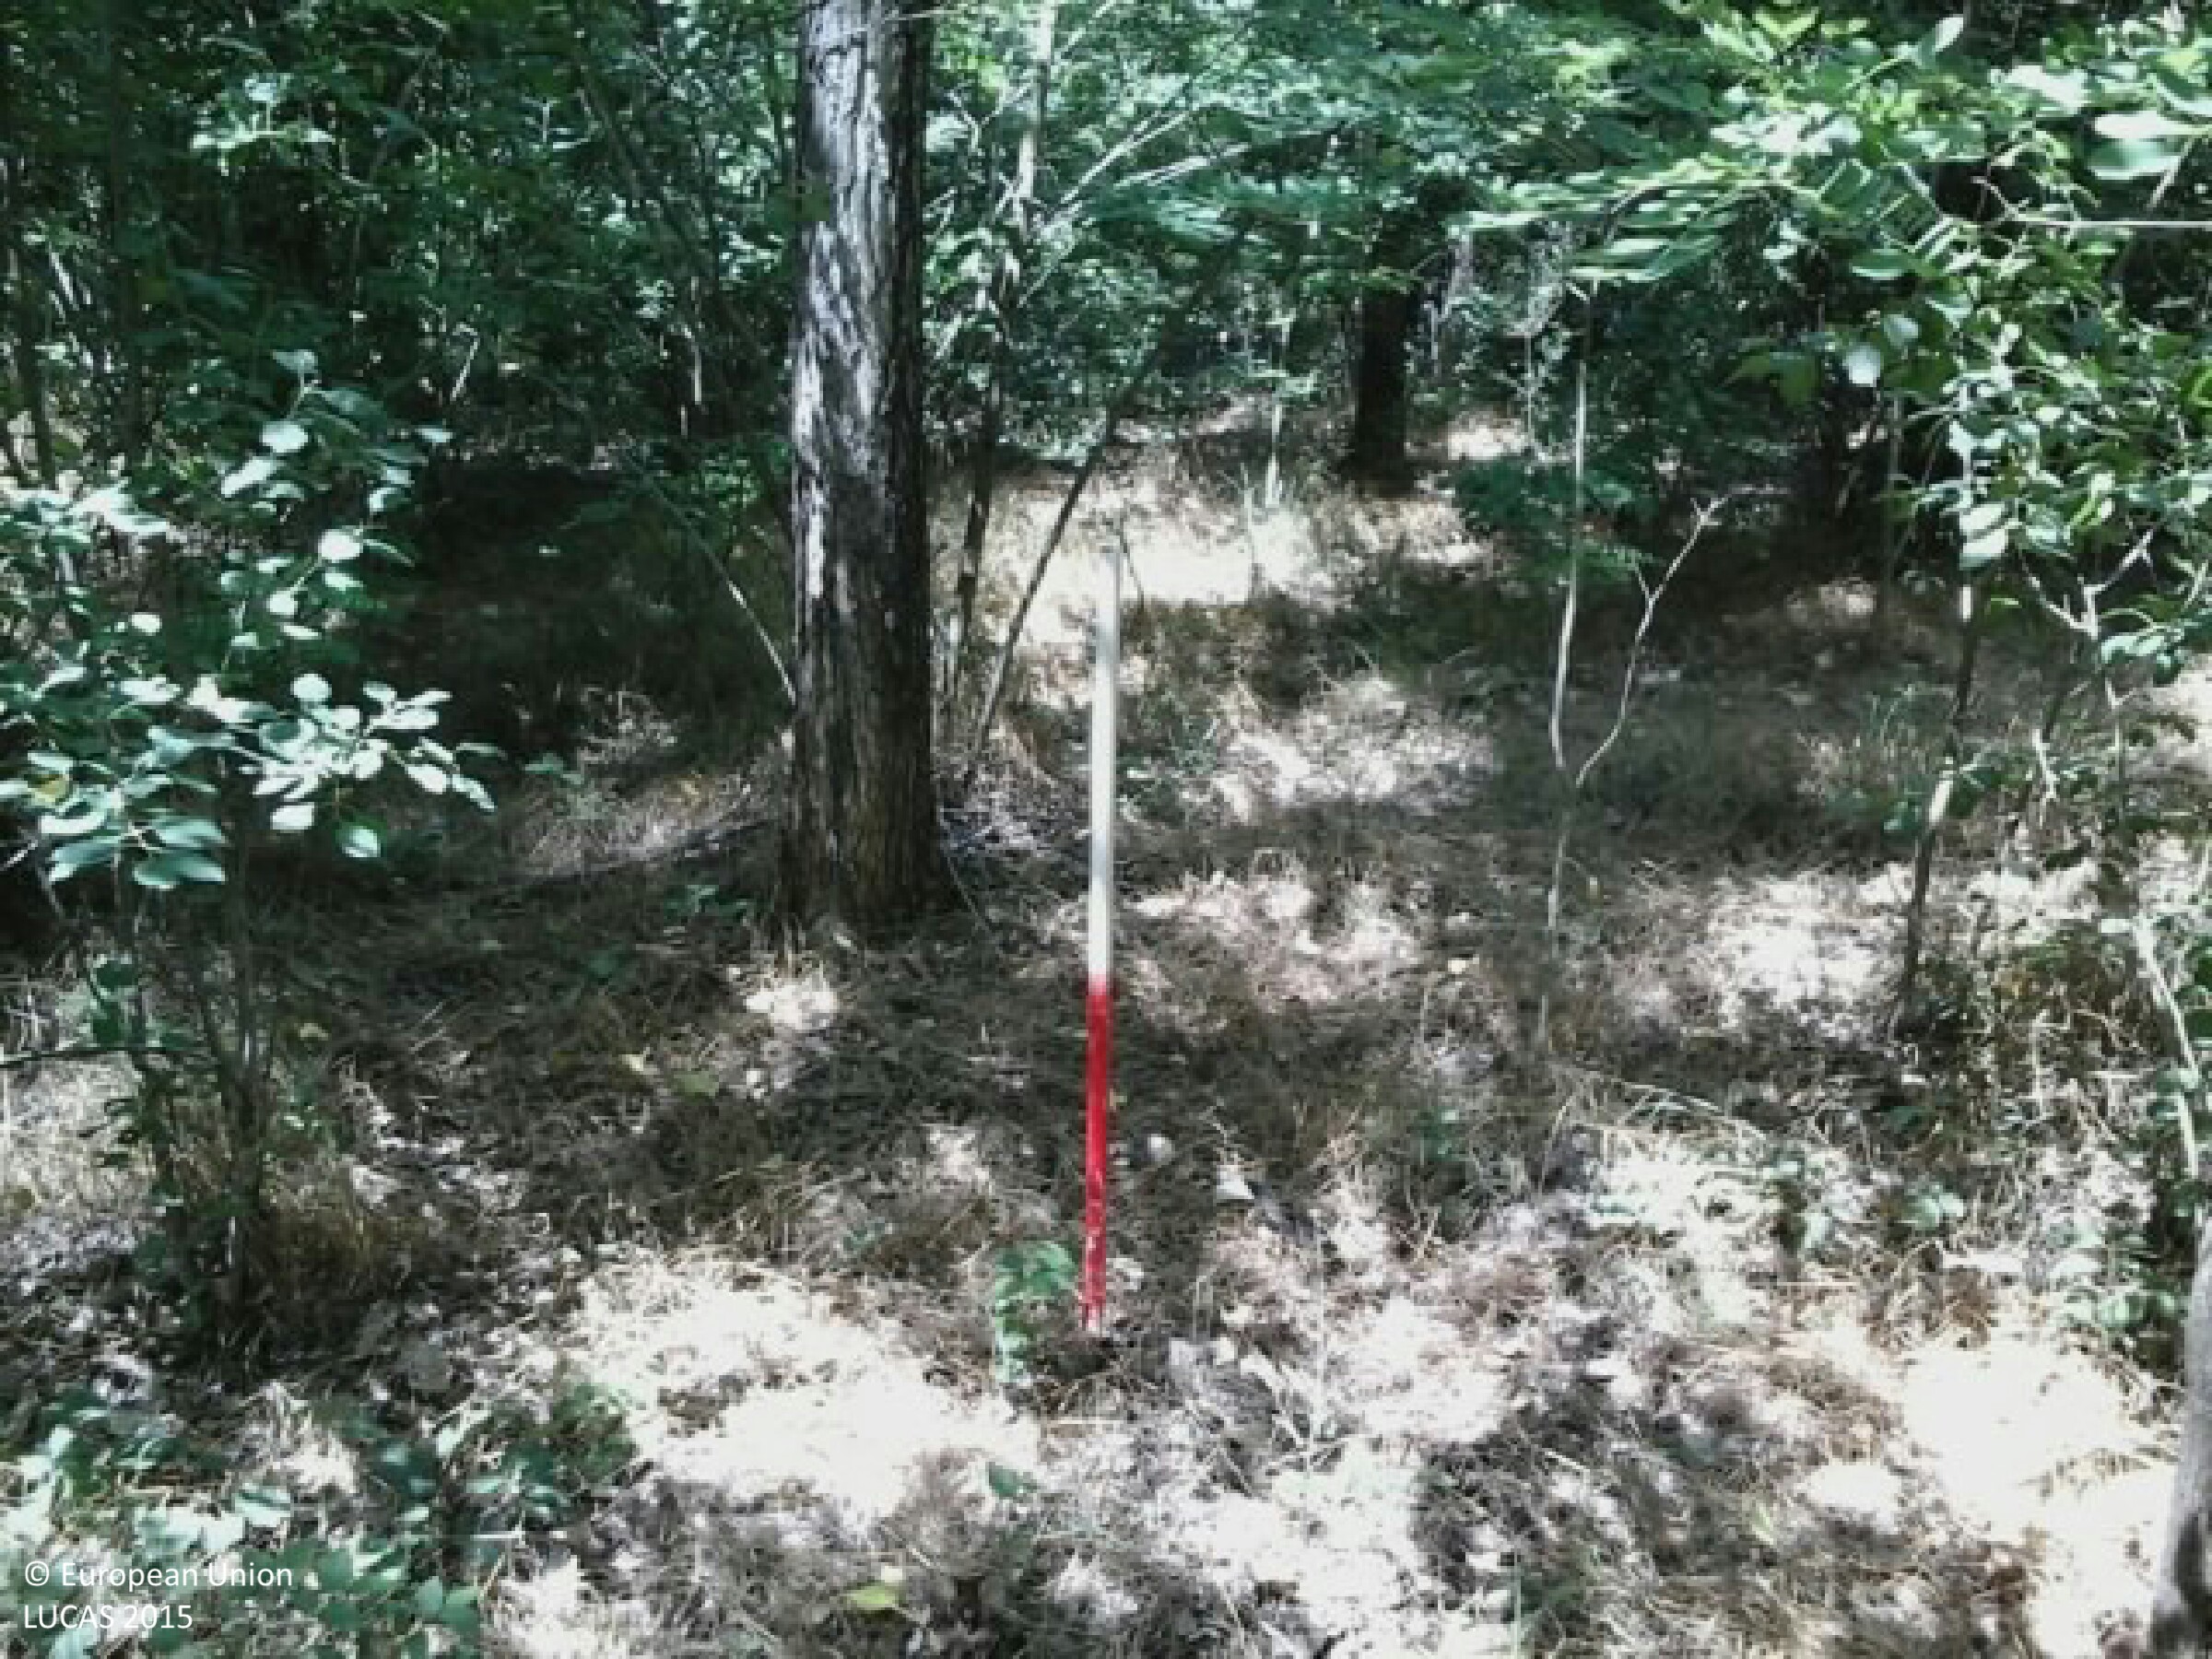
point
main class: Woodland
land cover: Broadleaved woodland
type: mesophytic deciduous forest
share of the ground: > 75 %
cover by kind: broadleaved forest trees 80 %, shrubs 20 %
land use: Forestry
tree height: < 5 m
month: June
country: HU
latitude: 46.1179
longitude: 18.9793
